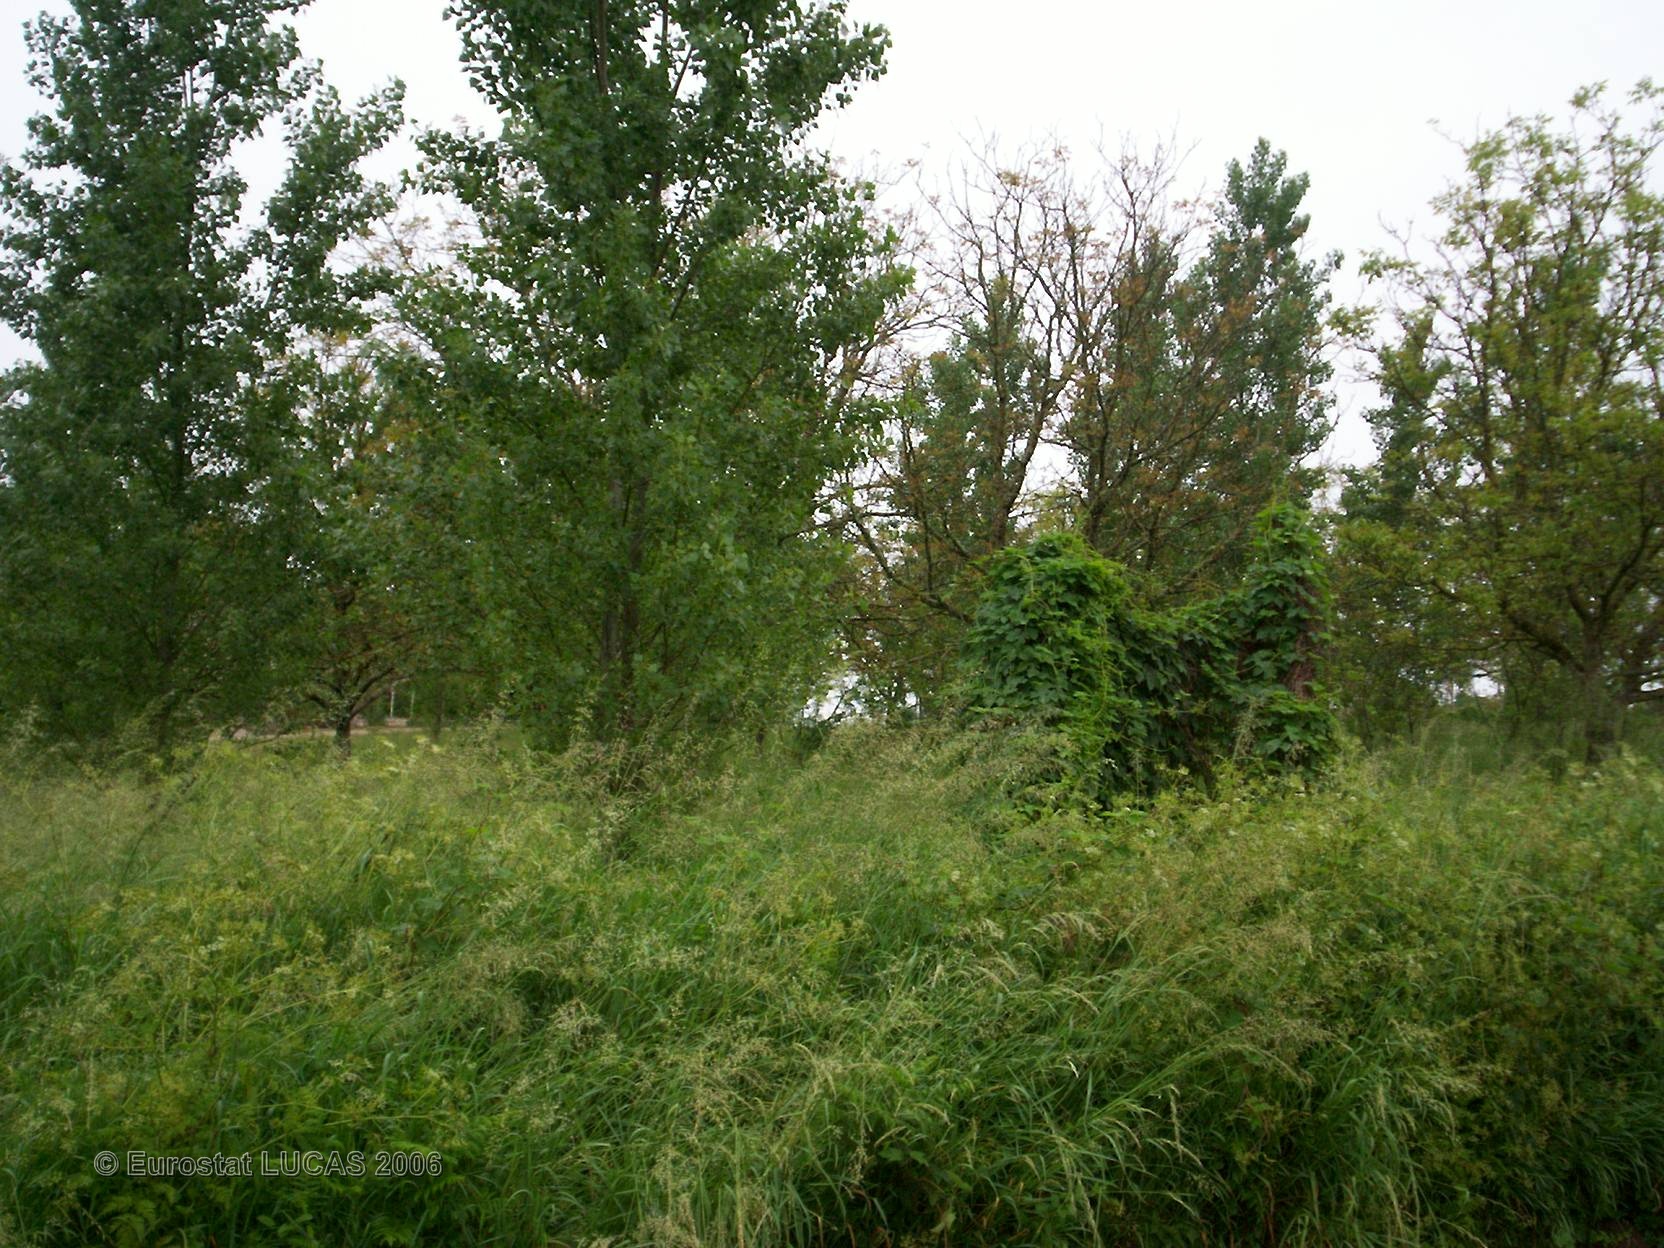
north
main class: Grassland
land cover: Grassland with sparse tree/shrub cover
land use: Agriculture (excluding fallow land and kitchen gardens)
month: May
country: FR
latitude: 44.7339
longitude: 1.3718
